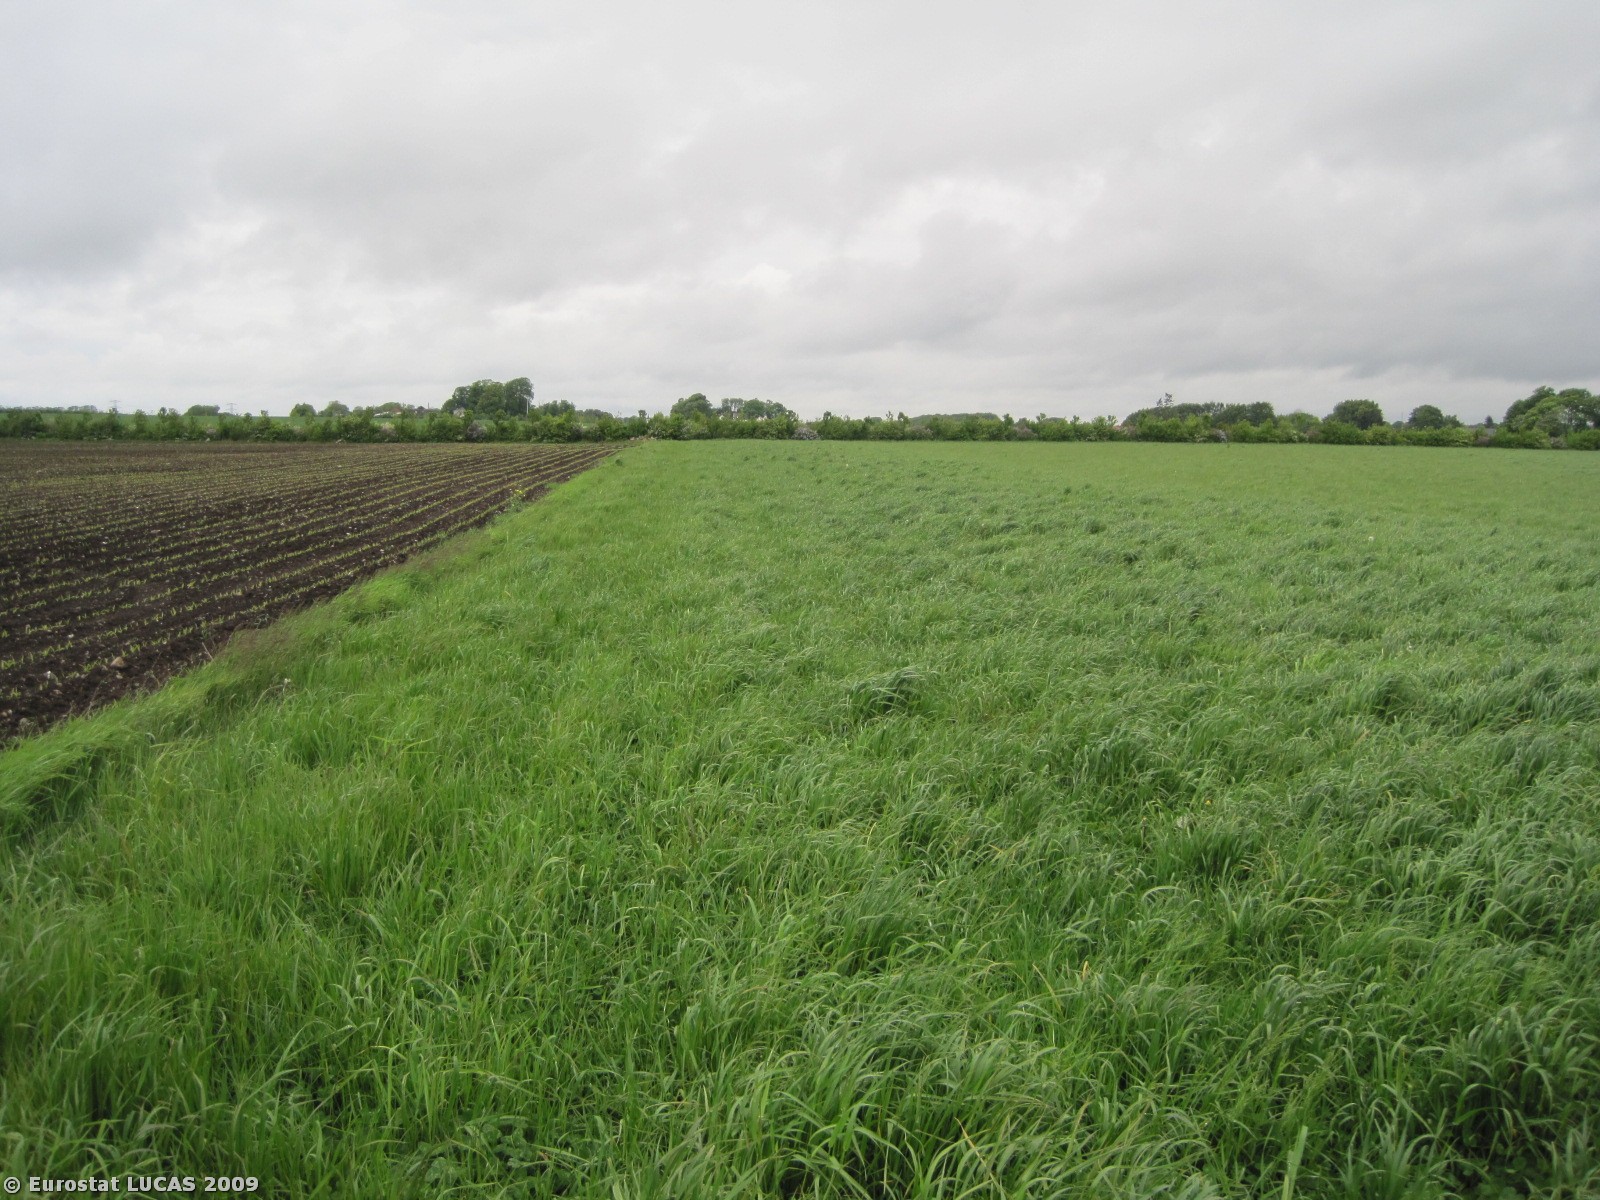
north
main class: Grassland
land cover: Grassland without tree/shrub cover
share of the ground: > 75 %
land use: Agriculture (excluding fallow land and kitchen gardens)
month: May
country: DK
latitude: 56.8345
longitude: 9.6890
